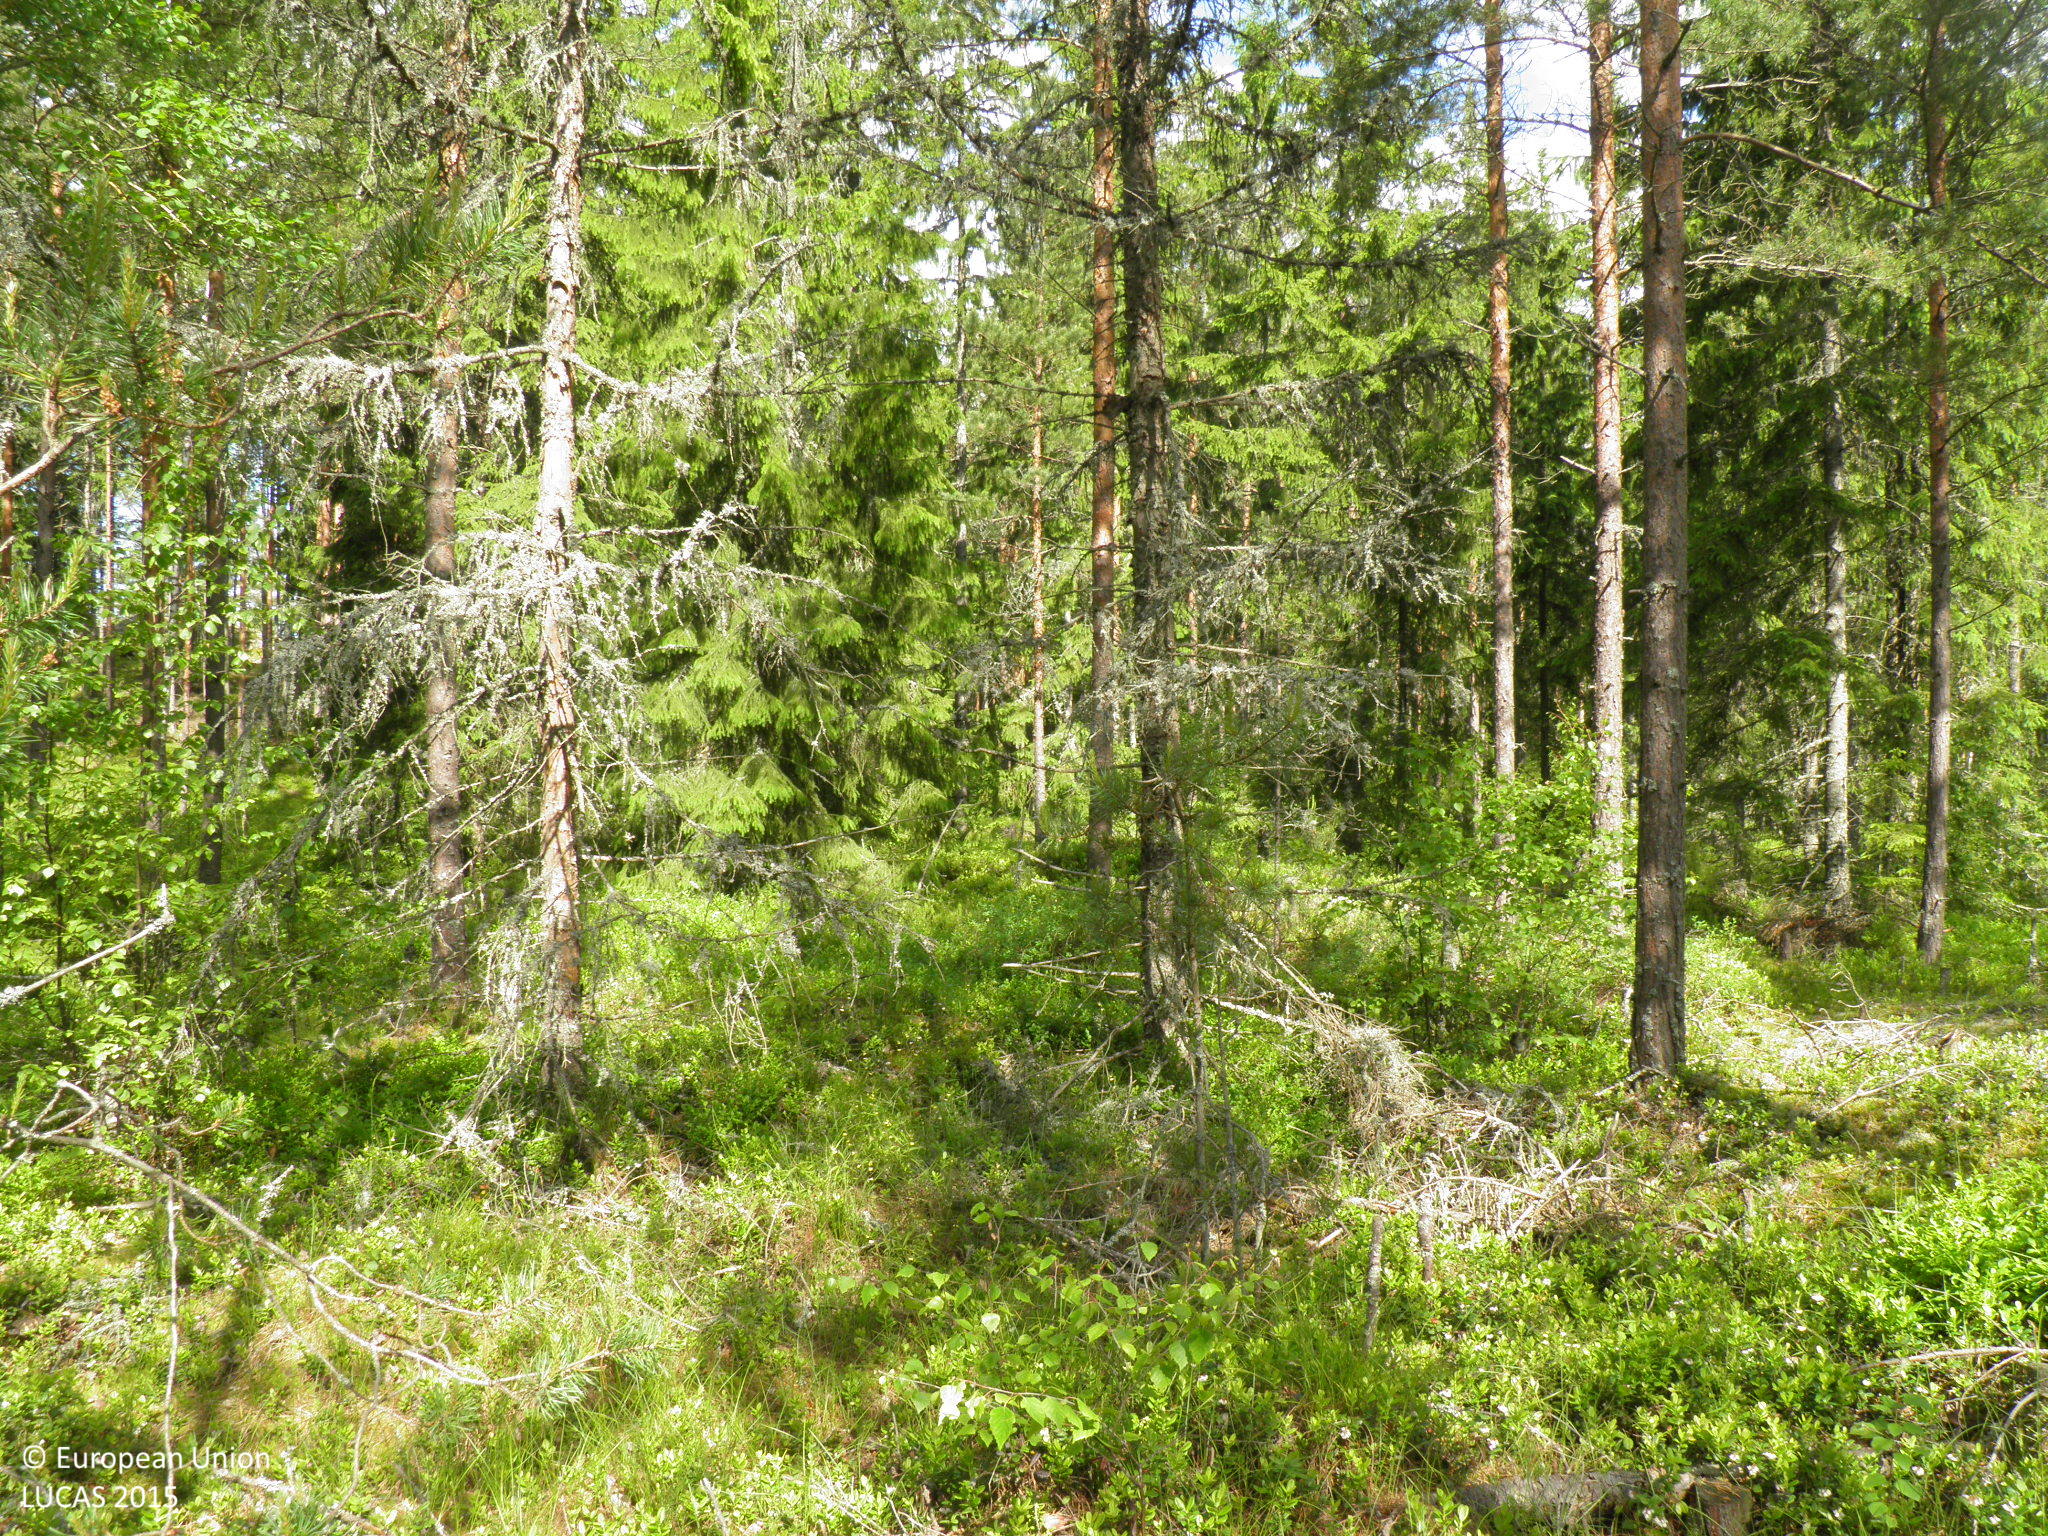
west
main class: Woodland
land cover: Pine dominated coniferous woodland
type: hemiboreal forest and nemoral coniferous forest and mixed broadleaved-coniferous forest
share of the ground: > 75 %
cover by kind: coniferous forest trees 70 %, shrubs 15 %, lichens and mosses 10 %, broadleaved forest trees 5 %
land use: Forestry
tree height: > 5 m
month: June
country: FI
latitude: 60.3441
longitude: 22.5926
